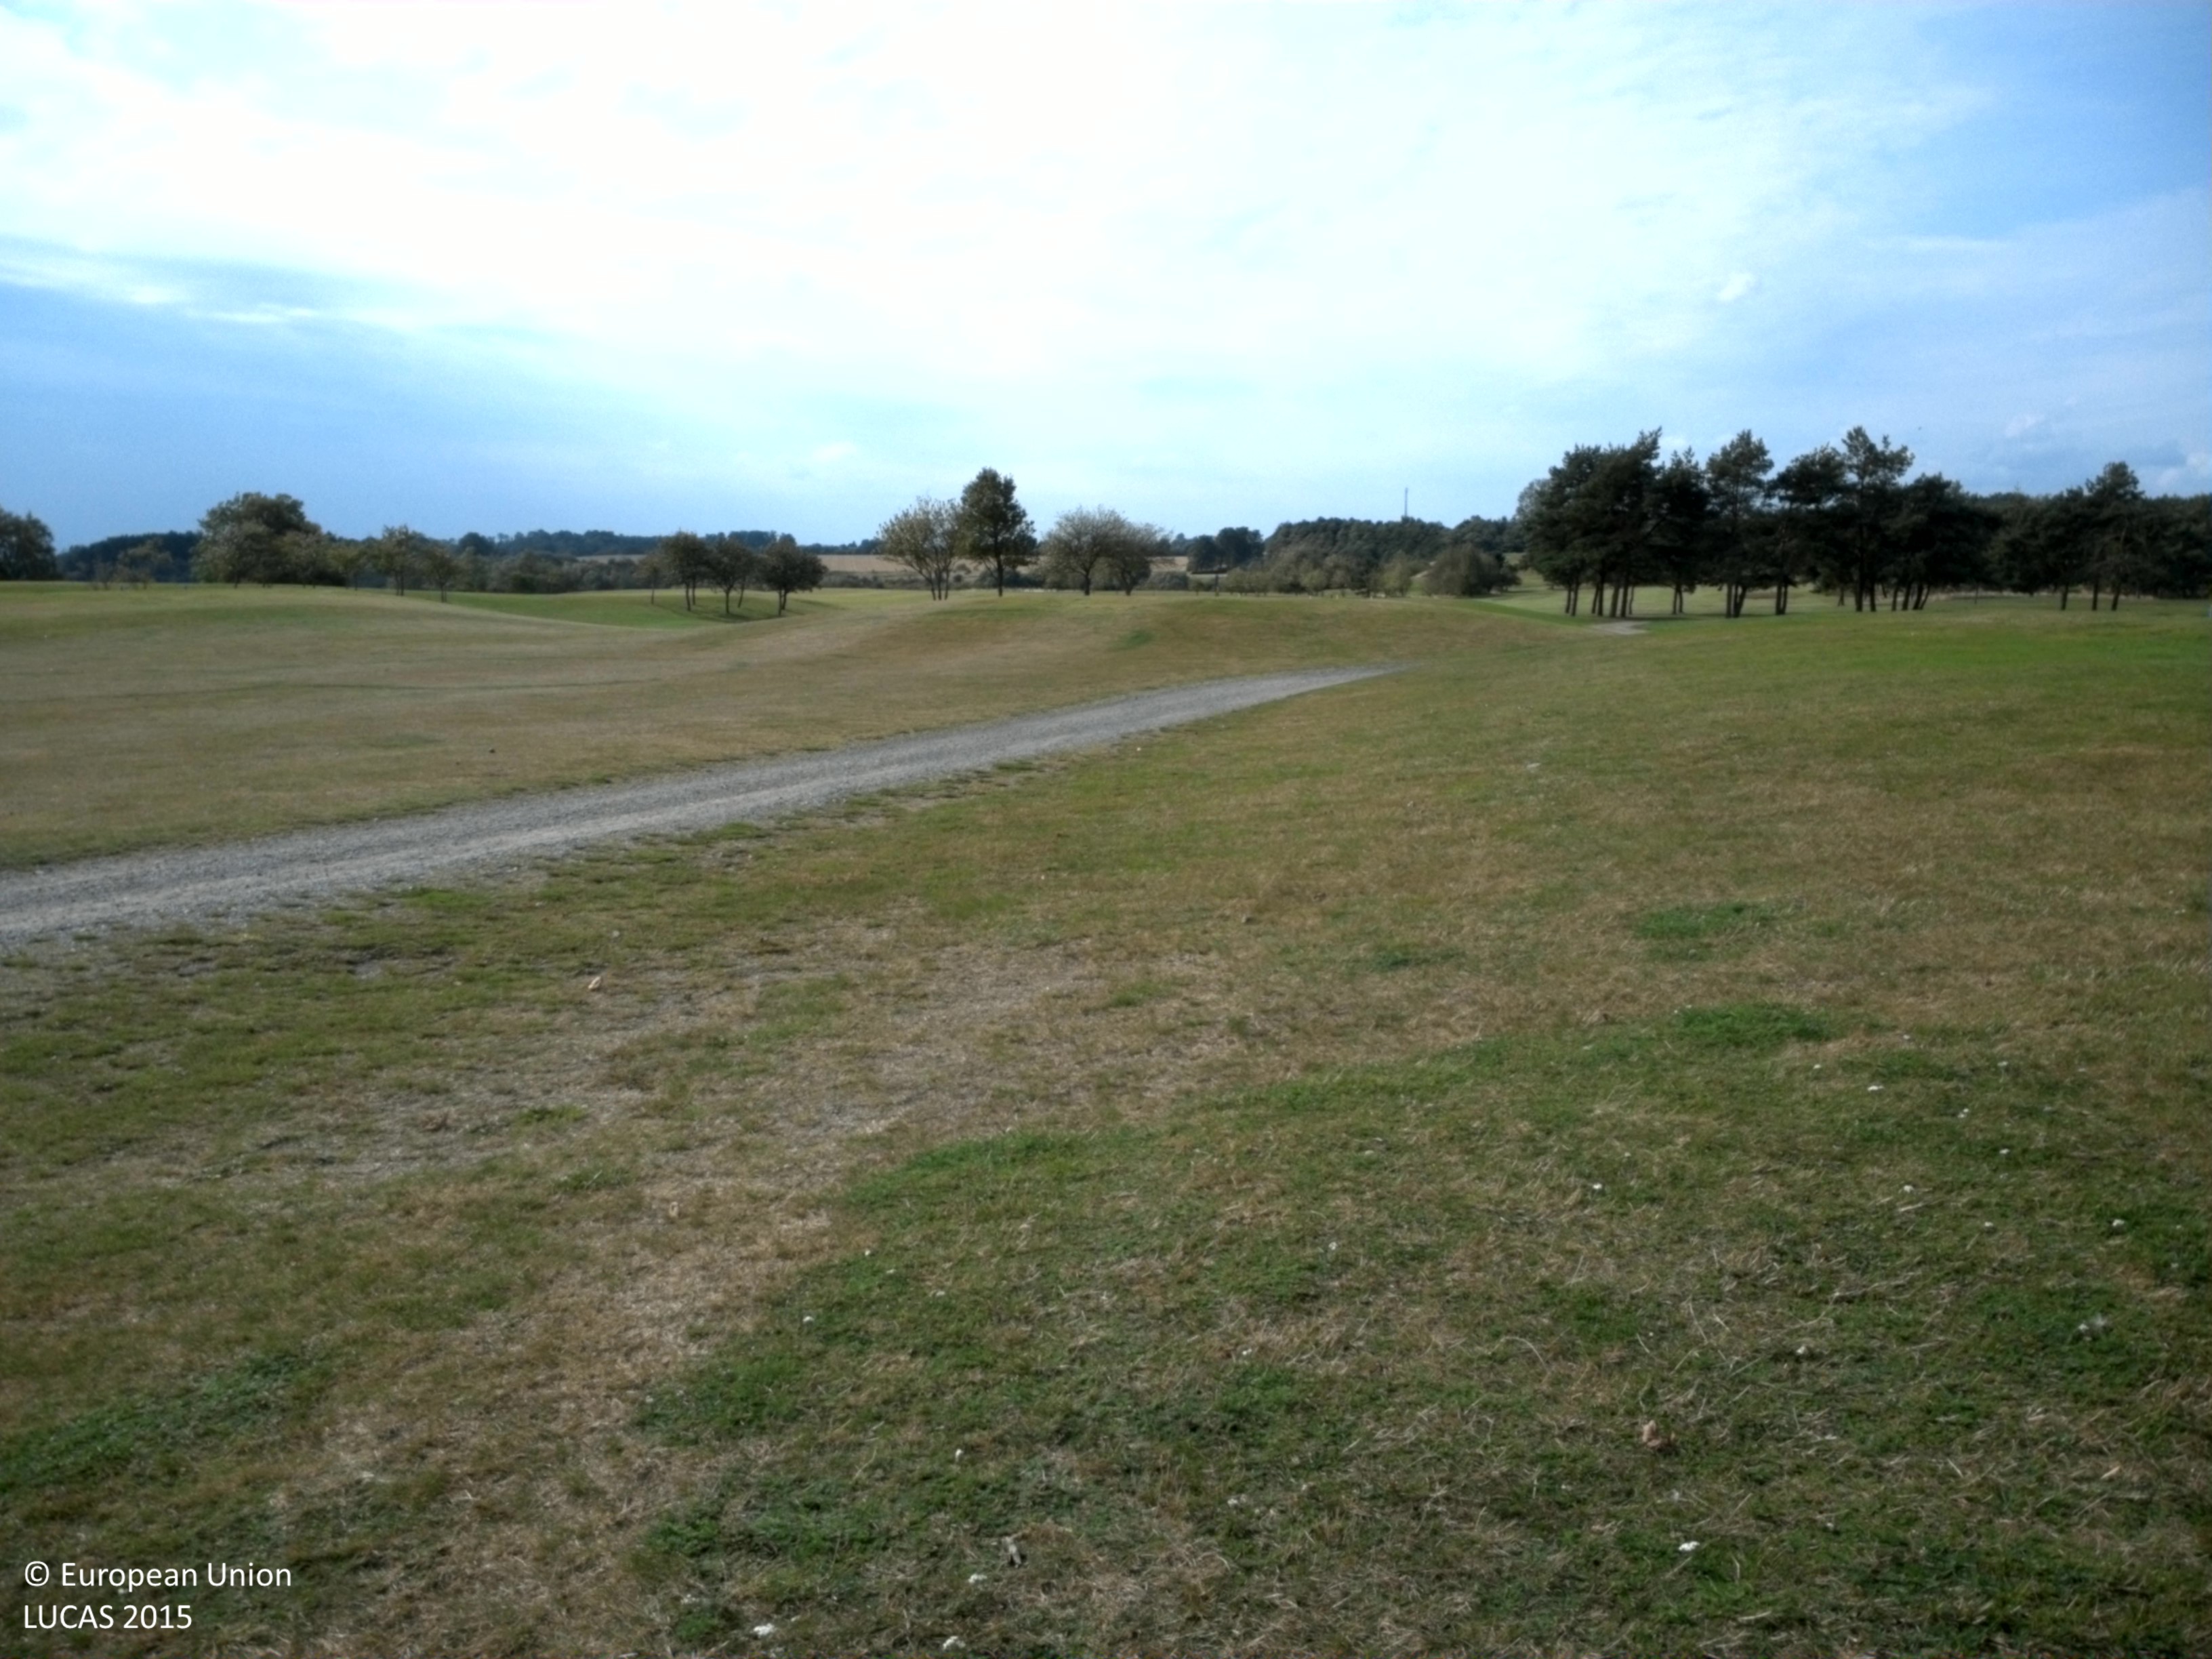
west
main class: Grassland
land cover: Grassland without tree/shrub cover
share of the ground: > 75 %
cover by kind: herbaceous plants 100 %
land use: Sport
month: September
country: SE
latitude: 55.5323
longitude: 13.9752
